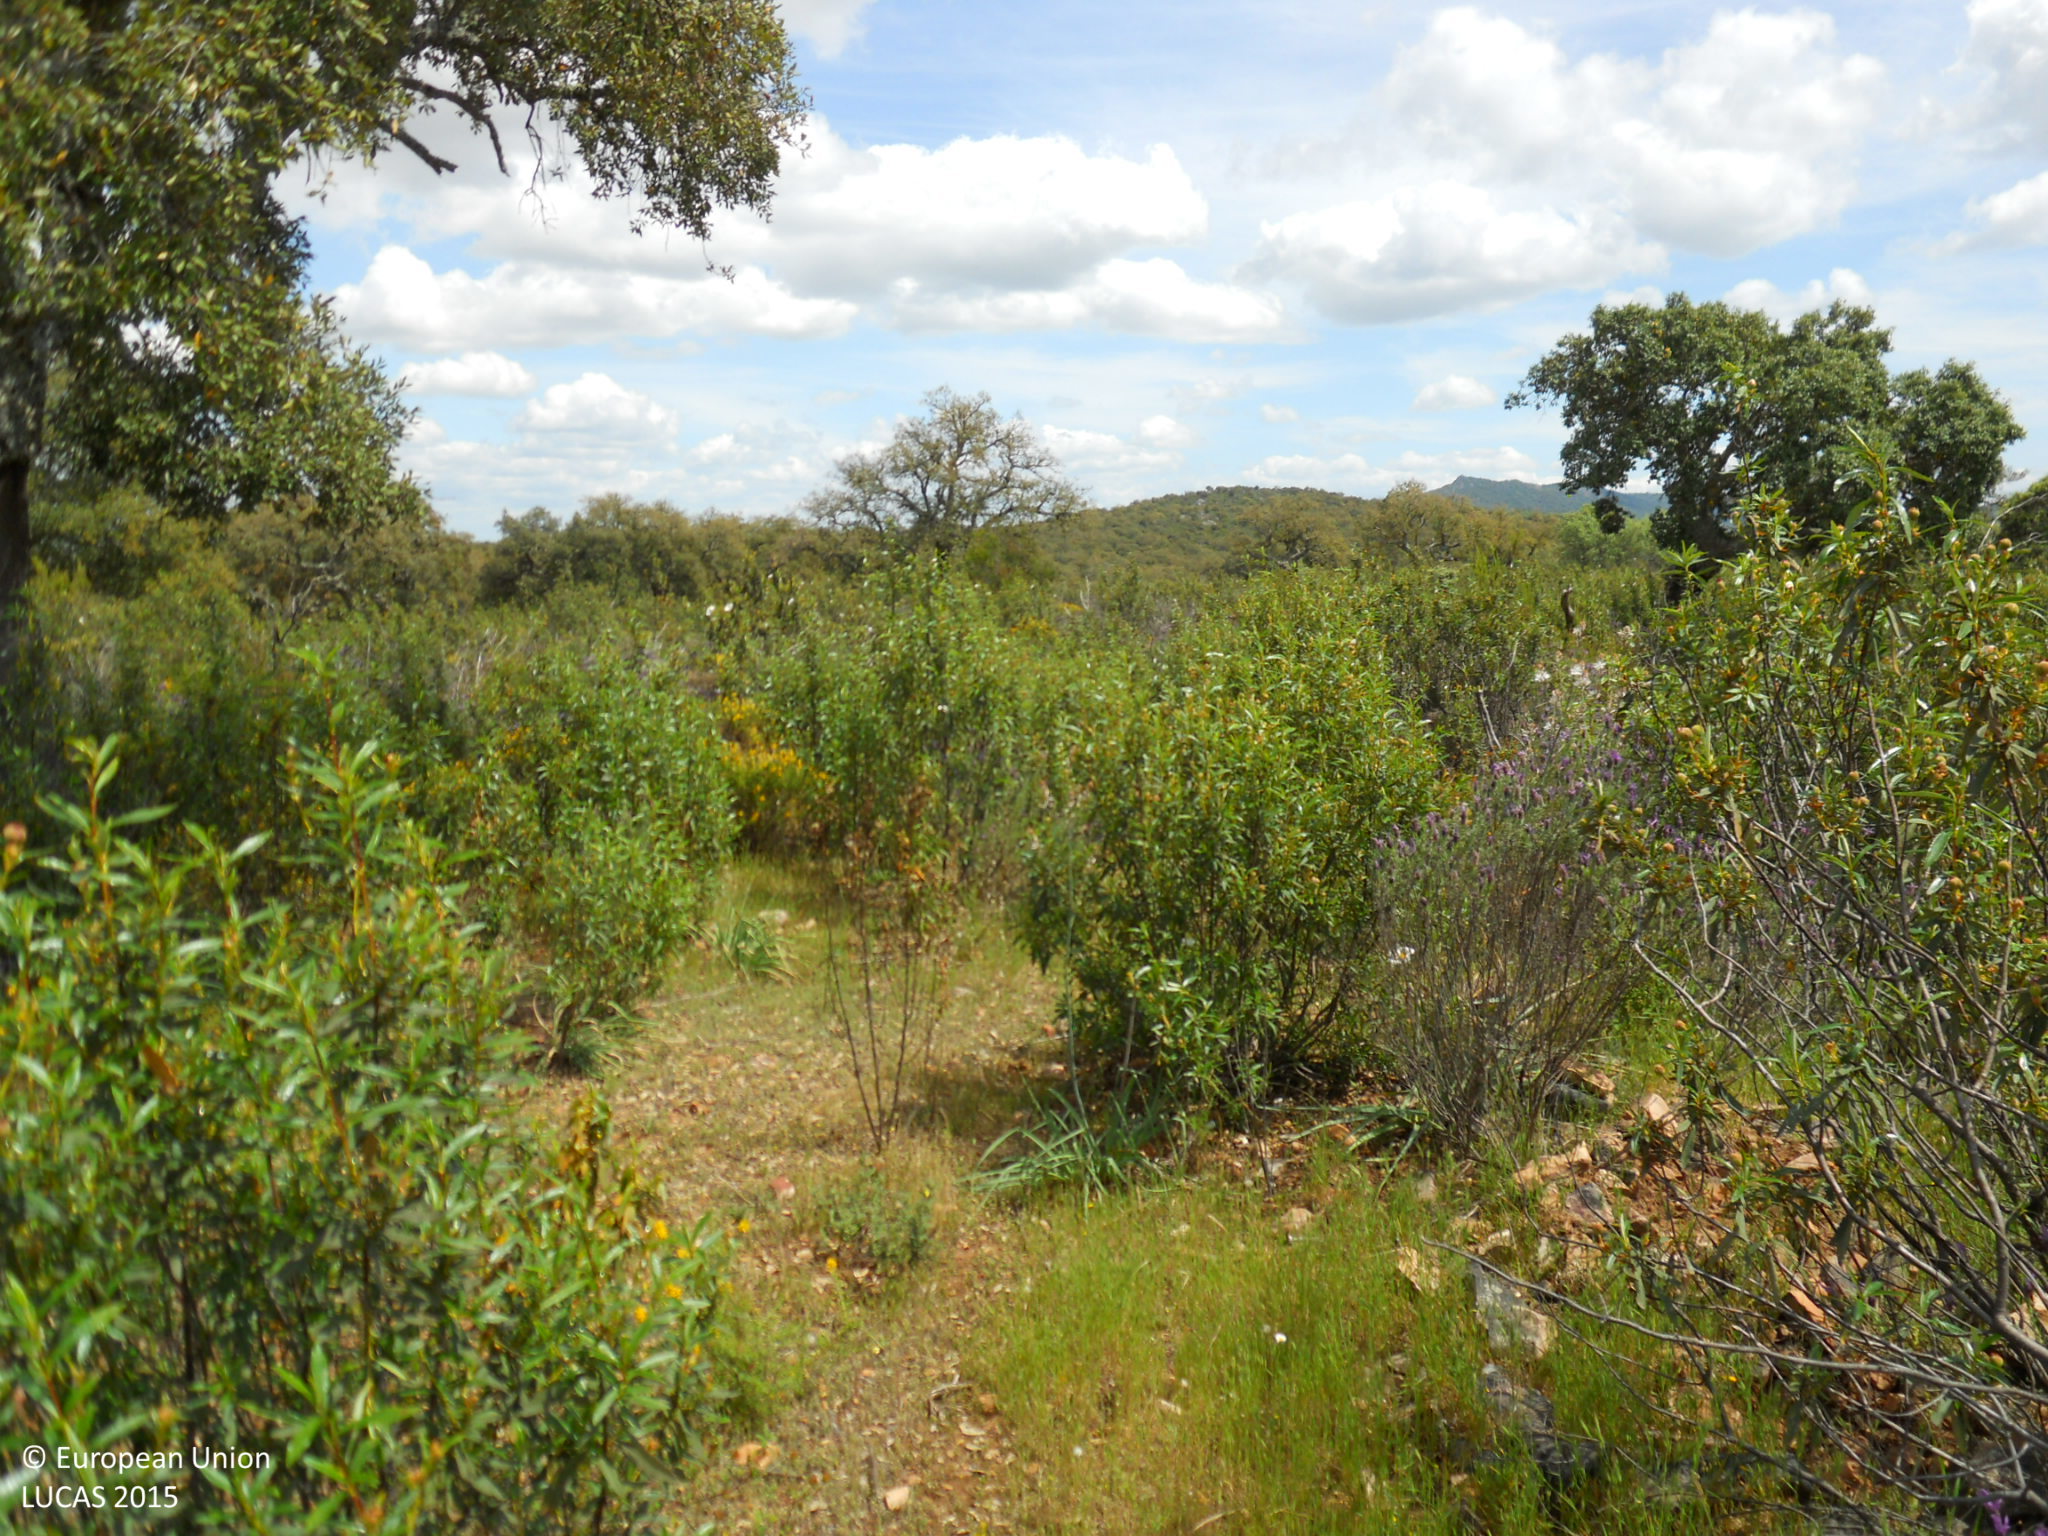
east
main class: Shrubland
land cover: Shrubland with sparse tree cover
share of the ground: > 75 %
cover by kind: shrubs 85 %, herbaceous plants 10 %, broadleaved forest trees 5 %
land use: Forestry
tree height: > 5 m
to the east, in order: Shrubland with sparse tree cover; Broadleaved woodland; Tracks; Broadleaved woodland
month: April
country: ES
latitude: 39.3115
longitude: -6.5491
